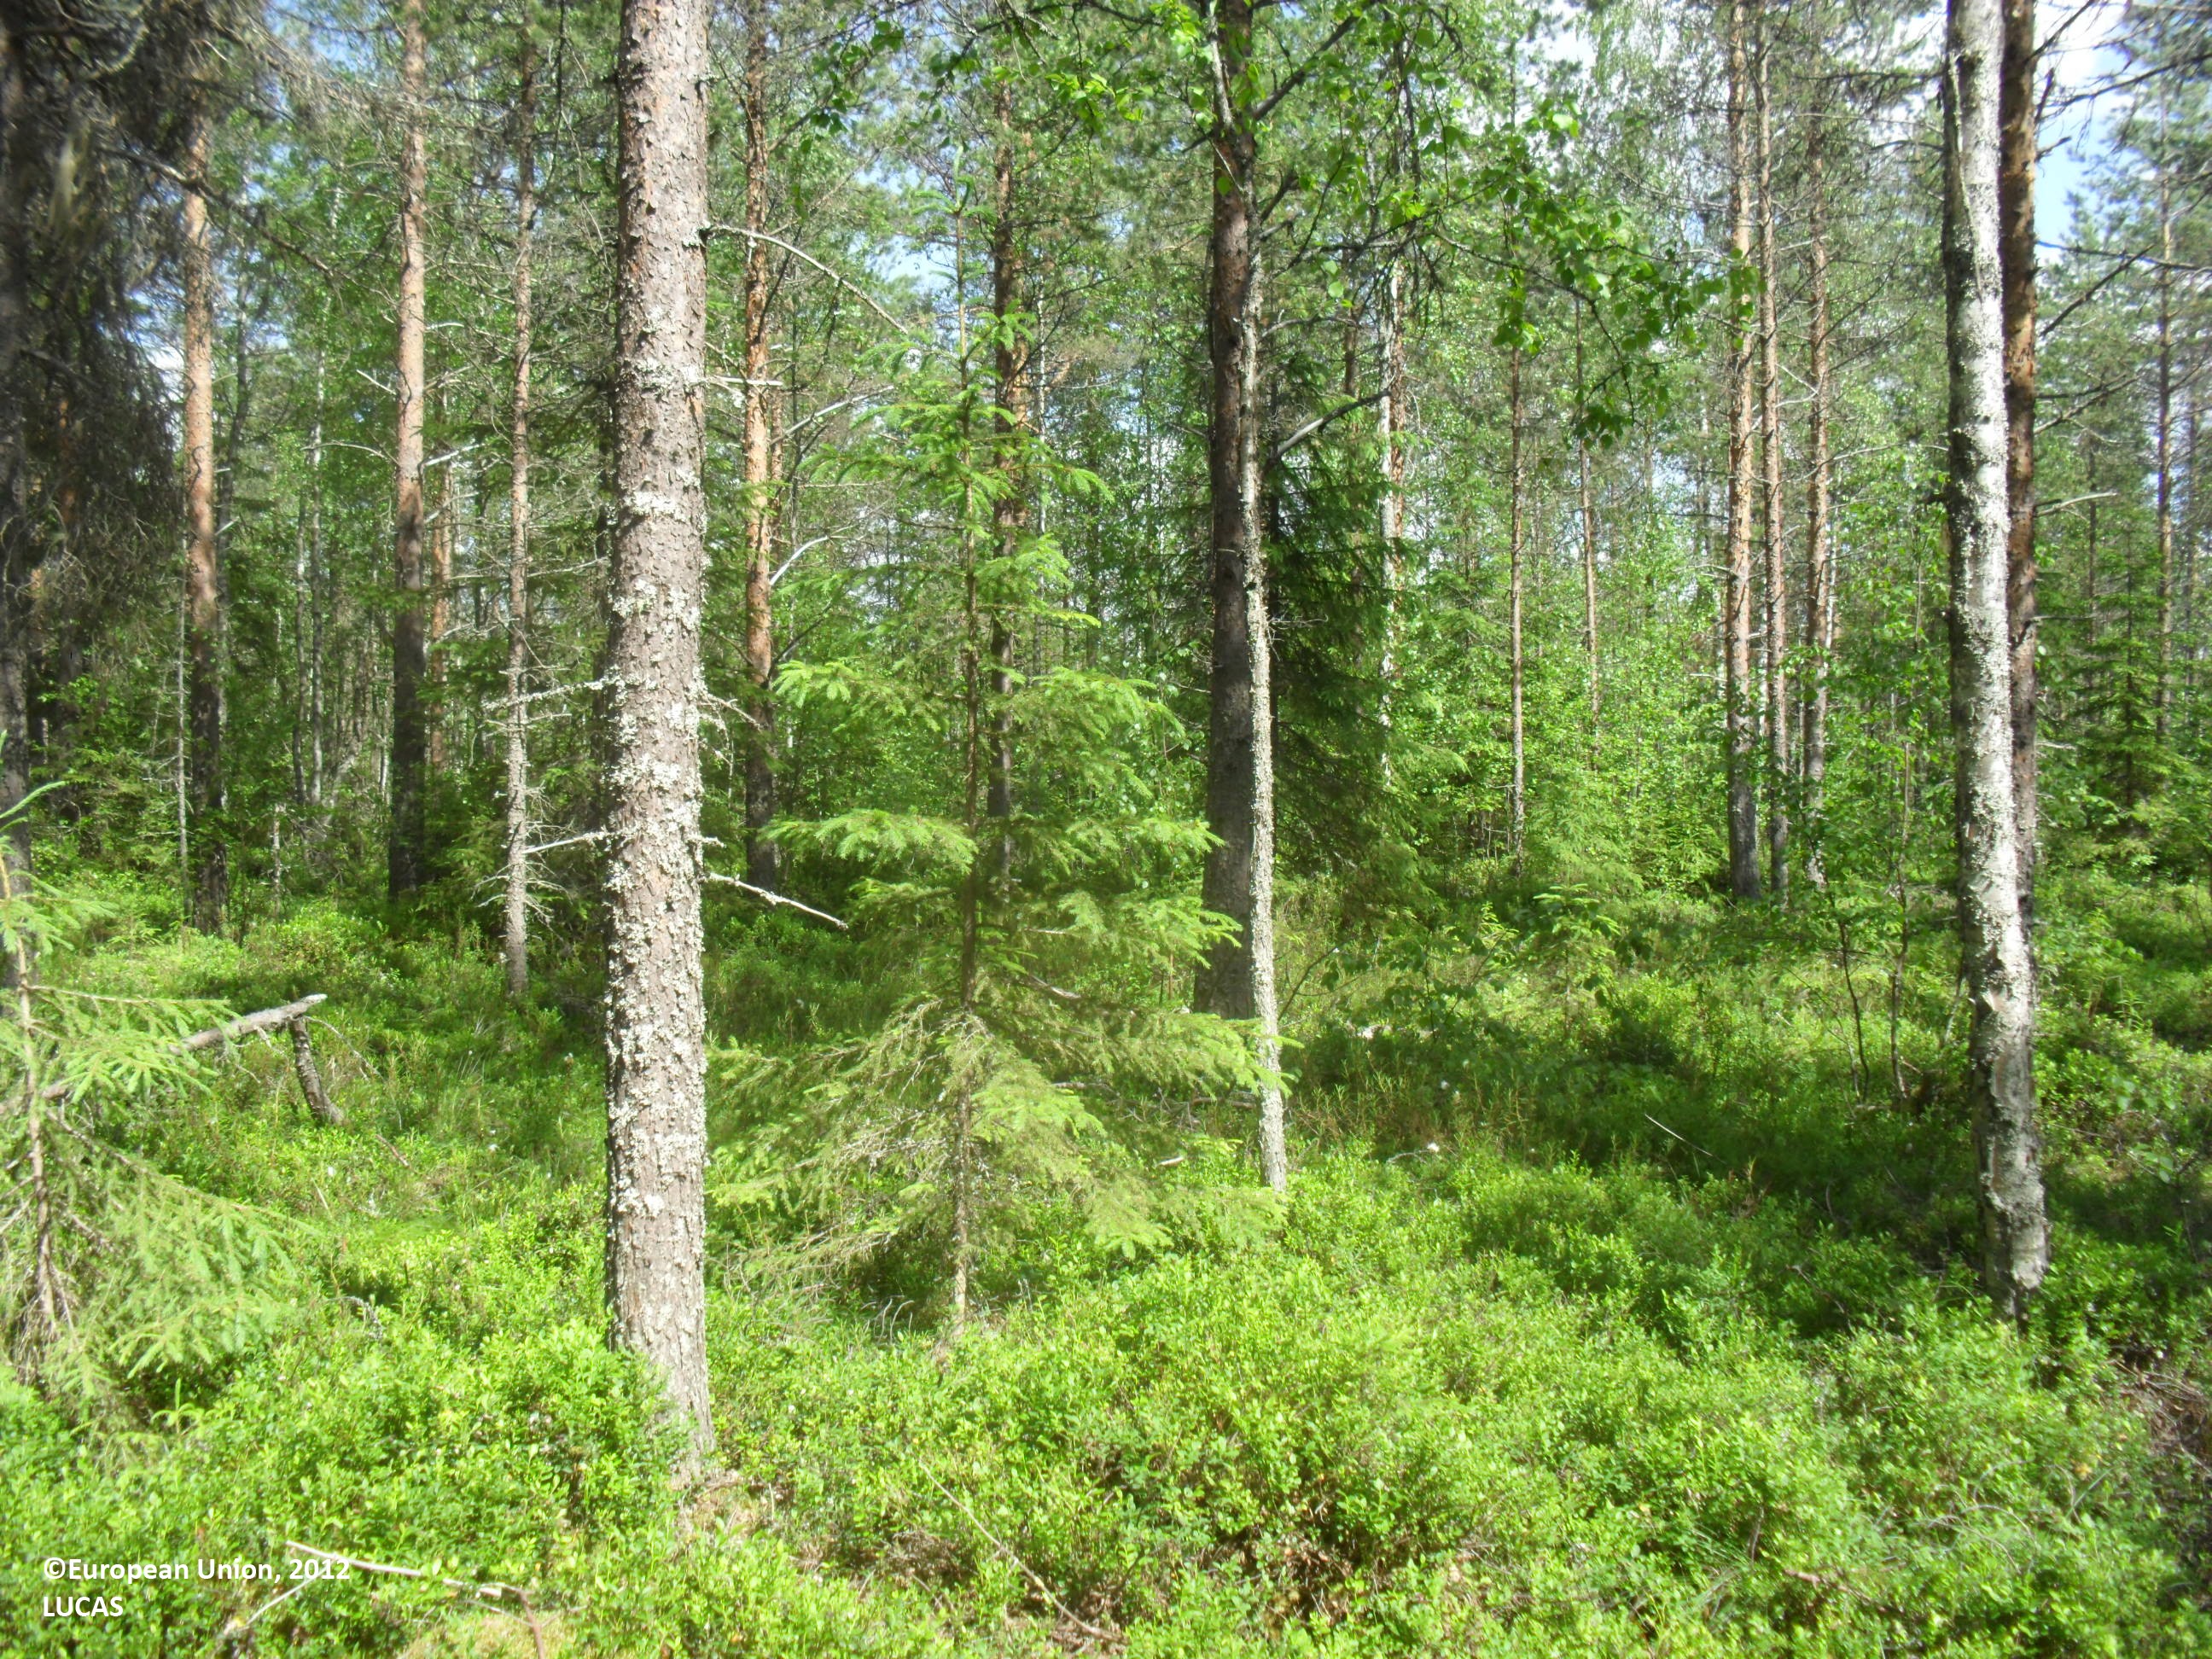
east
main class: Woodland
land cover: Other mixed woodland
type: boreal forest
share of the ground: 50 - 75 %
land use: Forestry
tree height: > 5 m
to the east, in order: Other mixed woodland; Ditches and canals; Other mixed woodland; Ditches and canals; Pine dominated mixed woodland; Ditches and canals; Pine dominated mixed woodland; Ditches and canals; Pine dominated mixed woodland; Ditches and canals; Pine dominated coniferous woodland
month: July
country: FI
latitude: 62.9412
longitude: 24.2477
